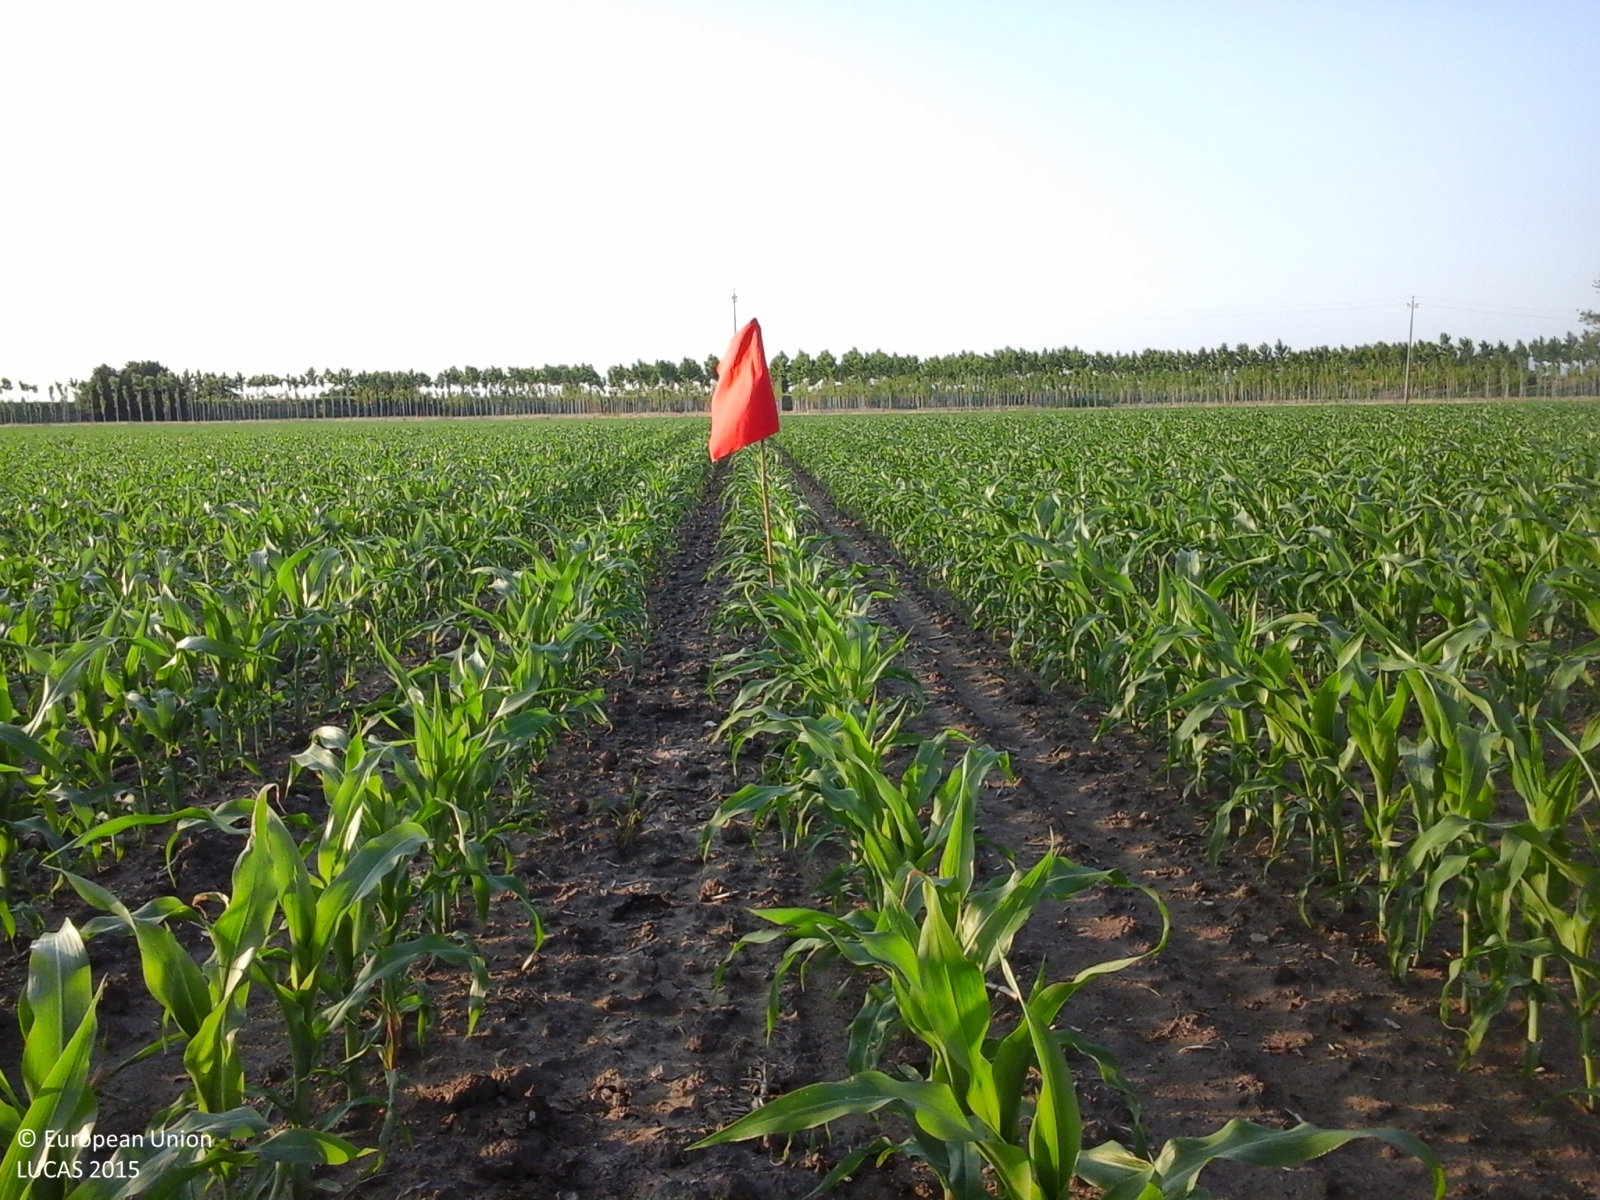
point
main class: Cropland
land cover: Maize
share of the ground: 25 - 50 %
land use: Agriculture (excluding fallow land and kitchen gardens)
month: May
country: IT
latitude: 45.1507
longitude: 11.5362
